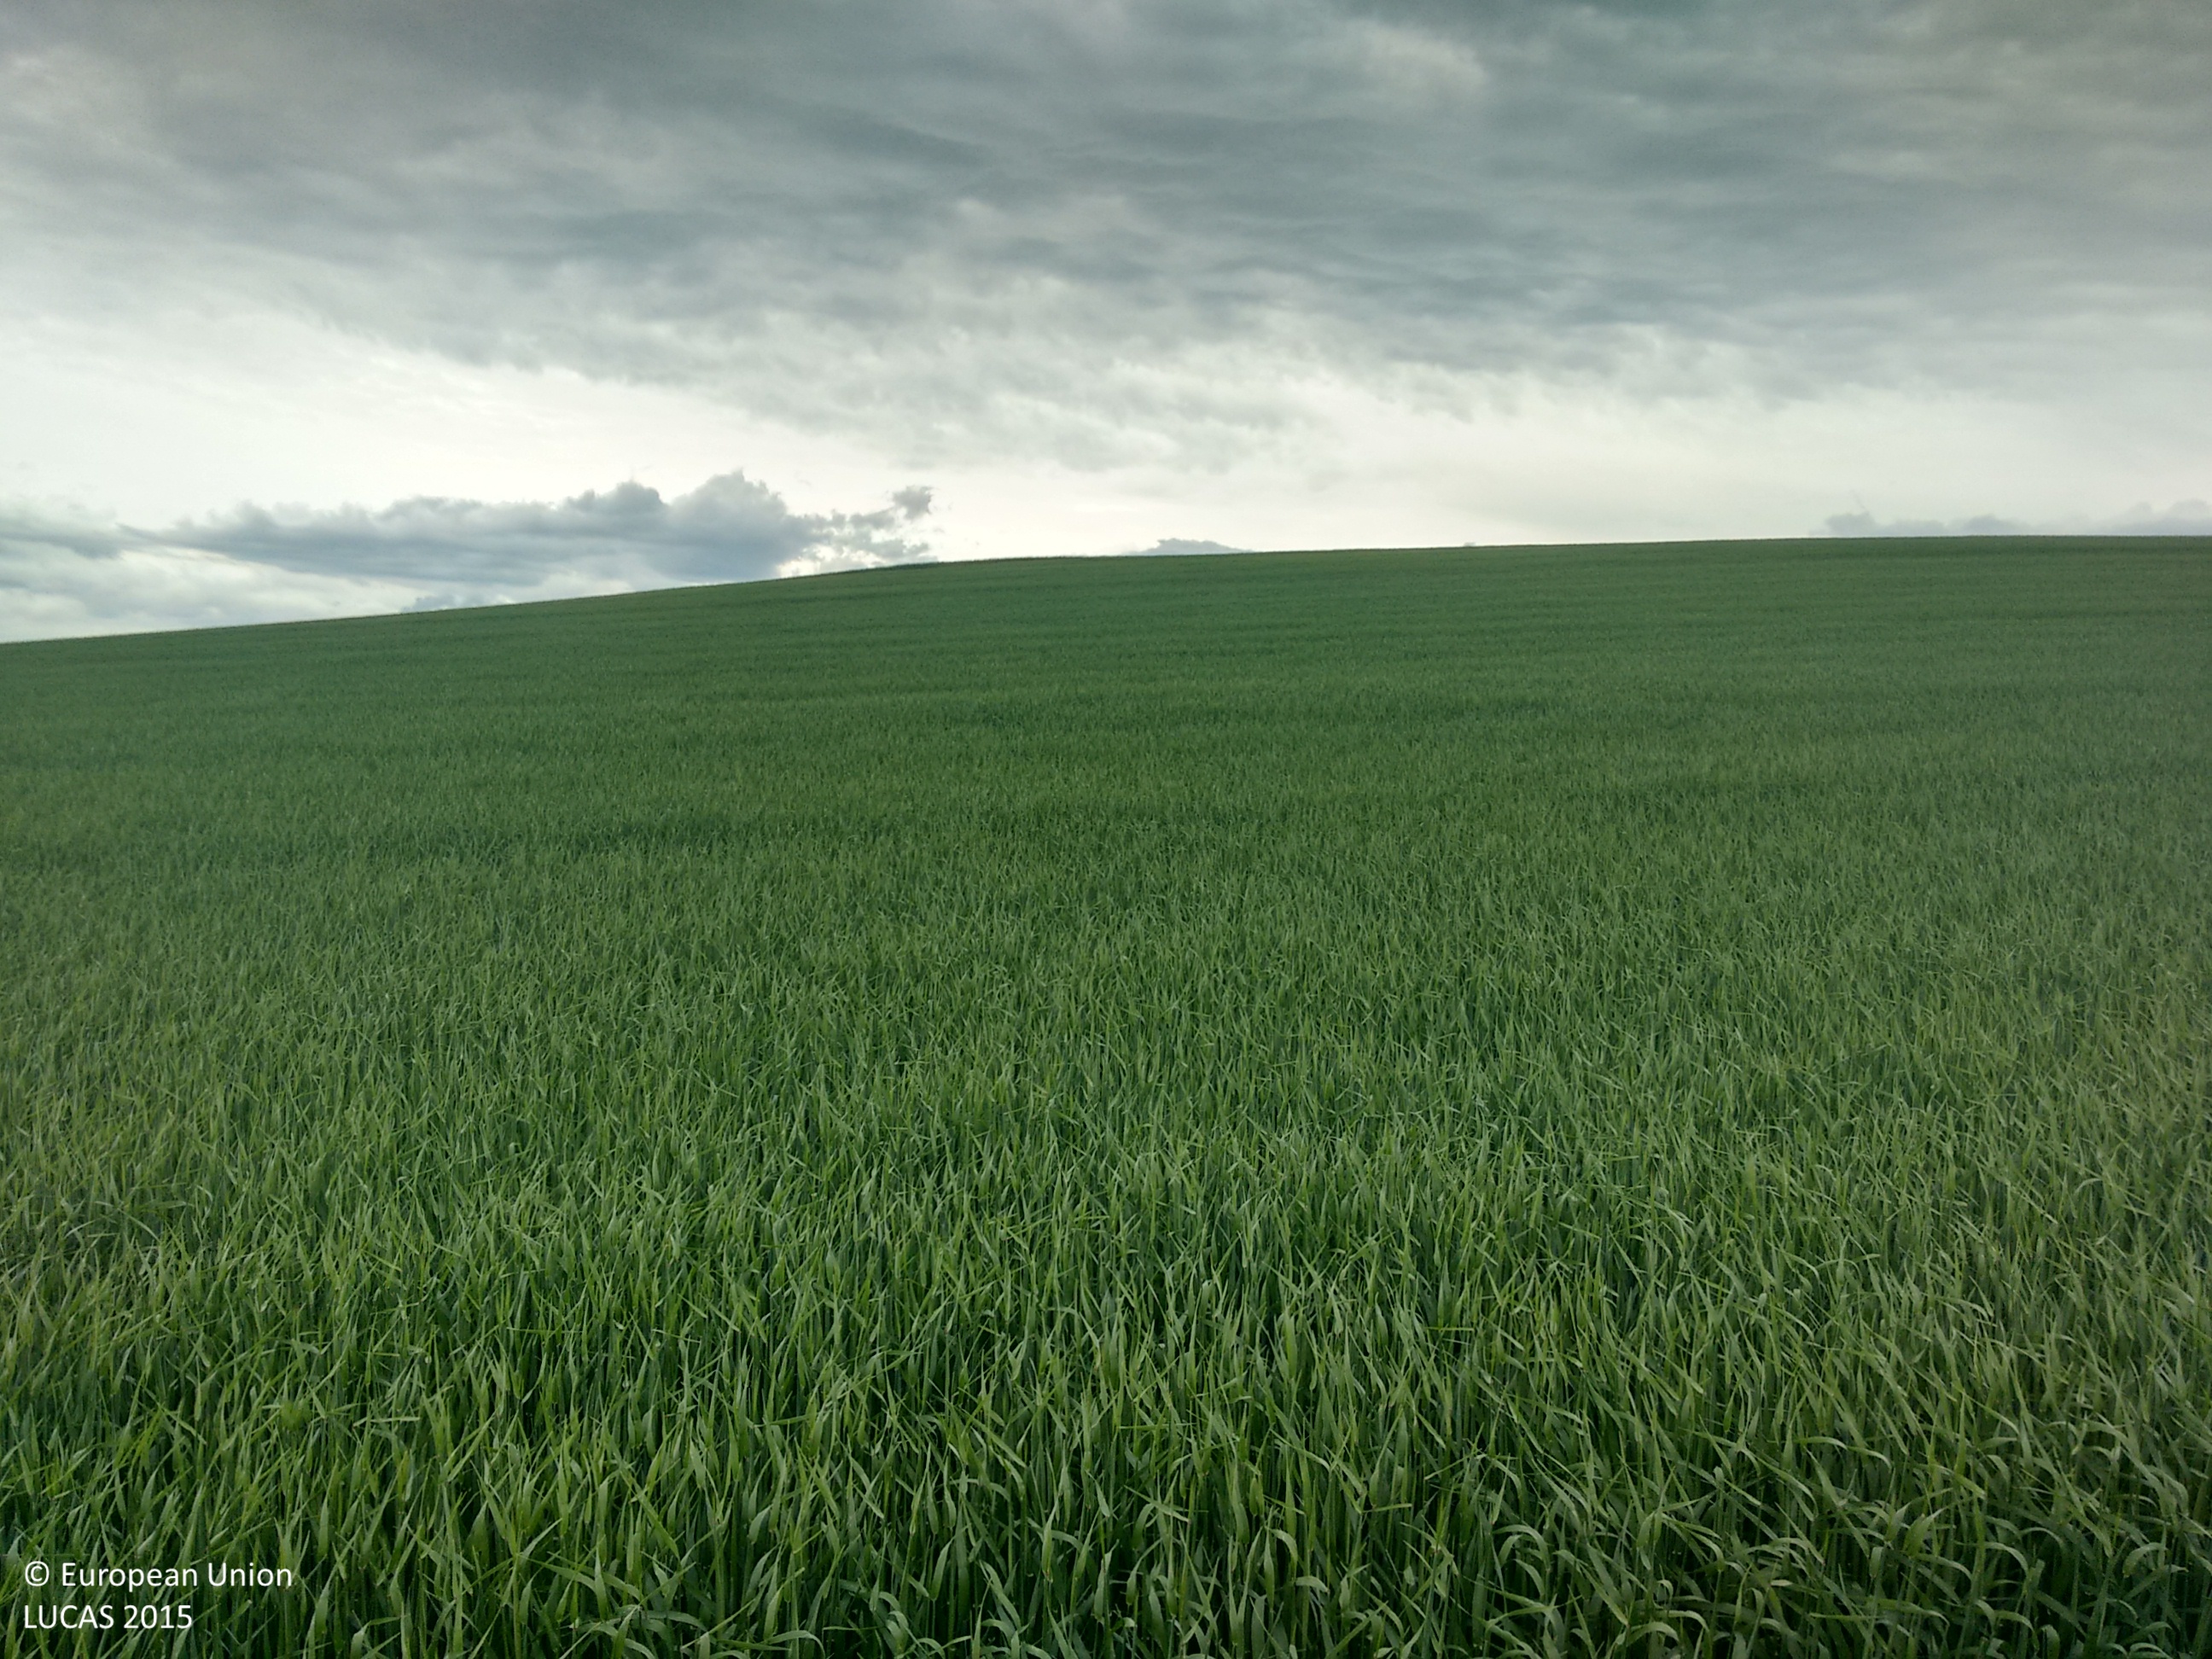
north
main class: Cropland
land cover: Barley
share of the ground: > 75 %
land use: Agriculture (excluding fallow land and kitchen gardens)
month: July
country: GB
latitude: 57.3194
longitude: -2.7272
